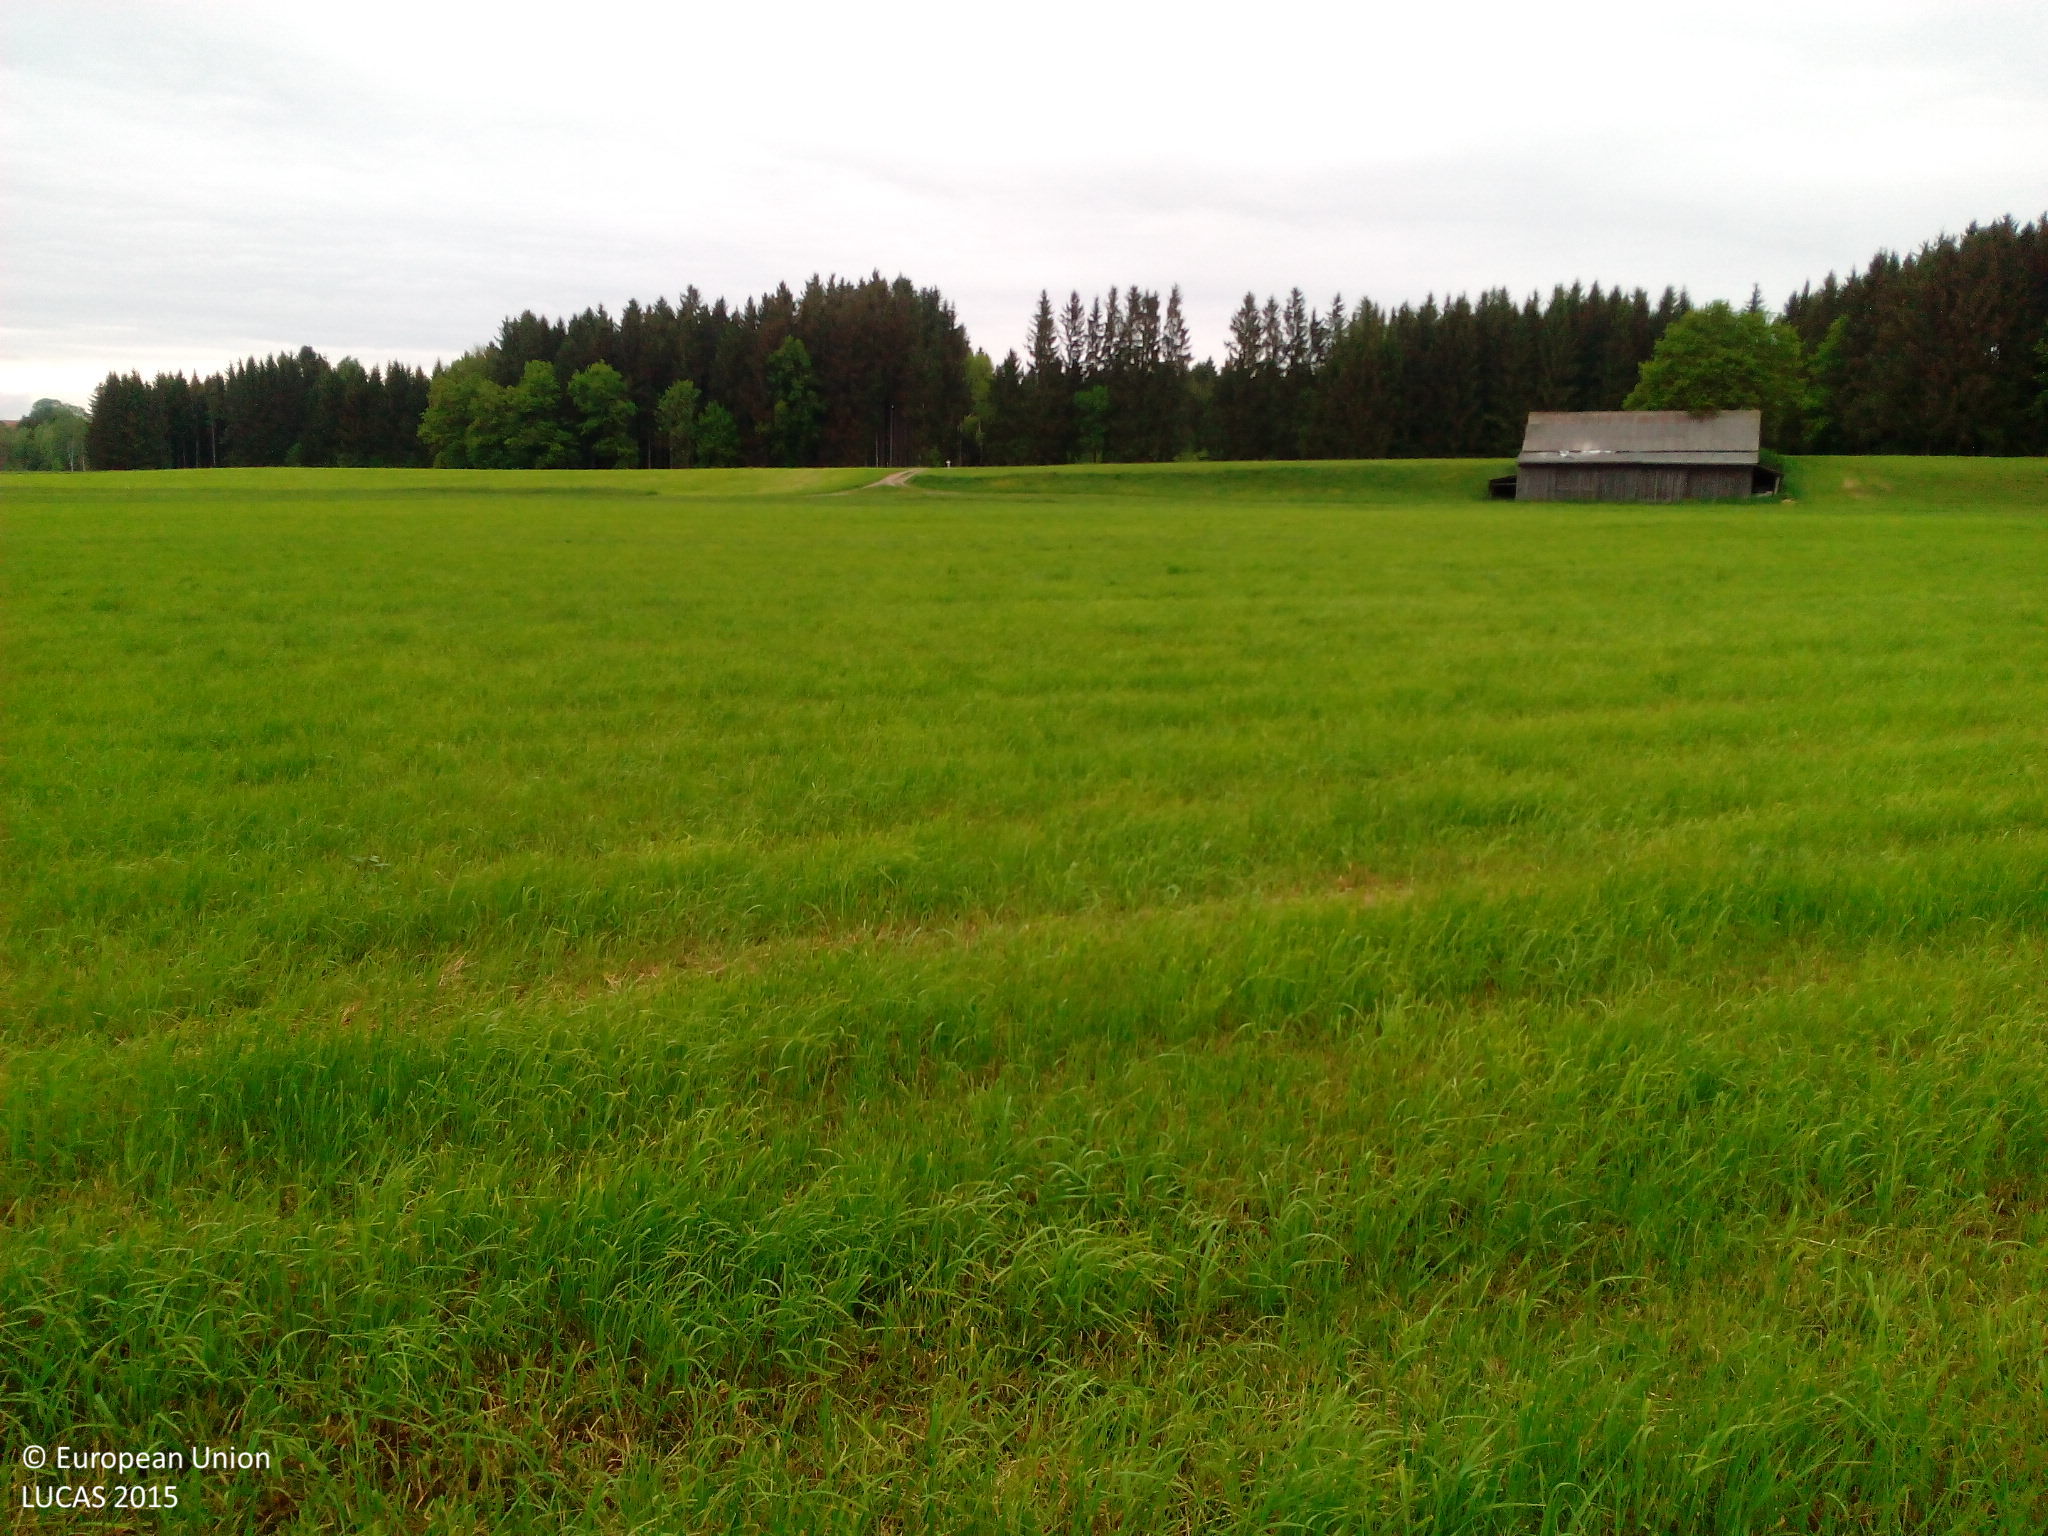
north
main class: Grassland
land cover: Grassland without tree/shrub cover
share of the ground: > 75 %
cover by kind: herbaceous plants 100 %
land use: Agriculture (excluding fallow land and kitchen gardens)
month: May
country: DE
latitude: 47.8816
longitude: 9.9332
